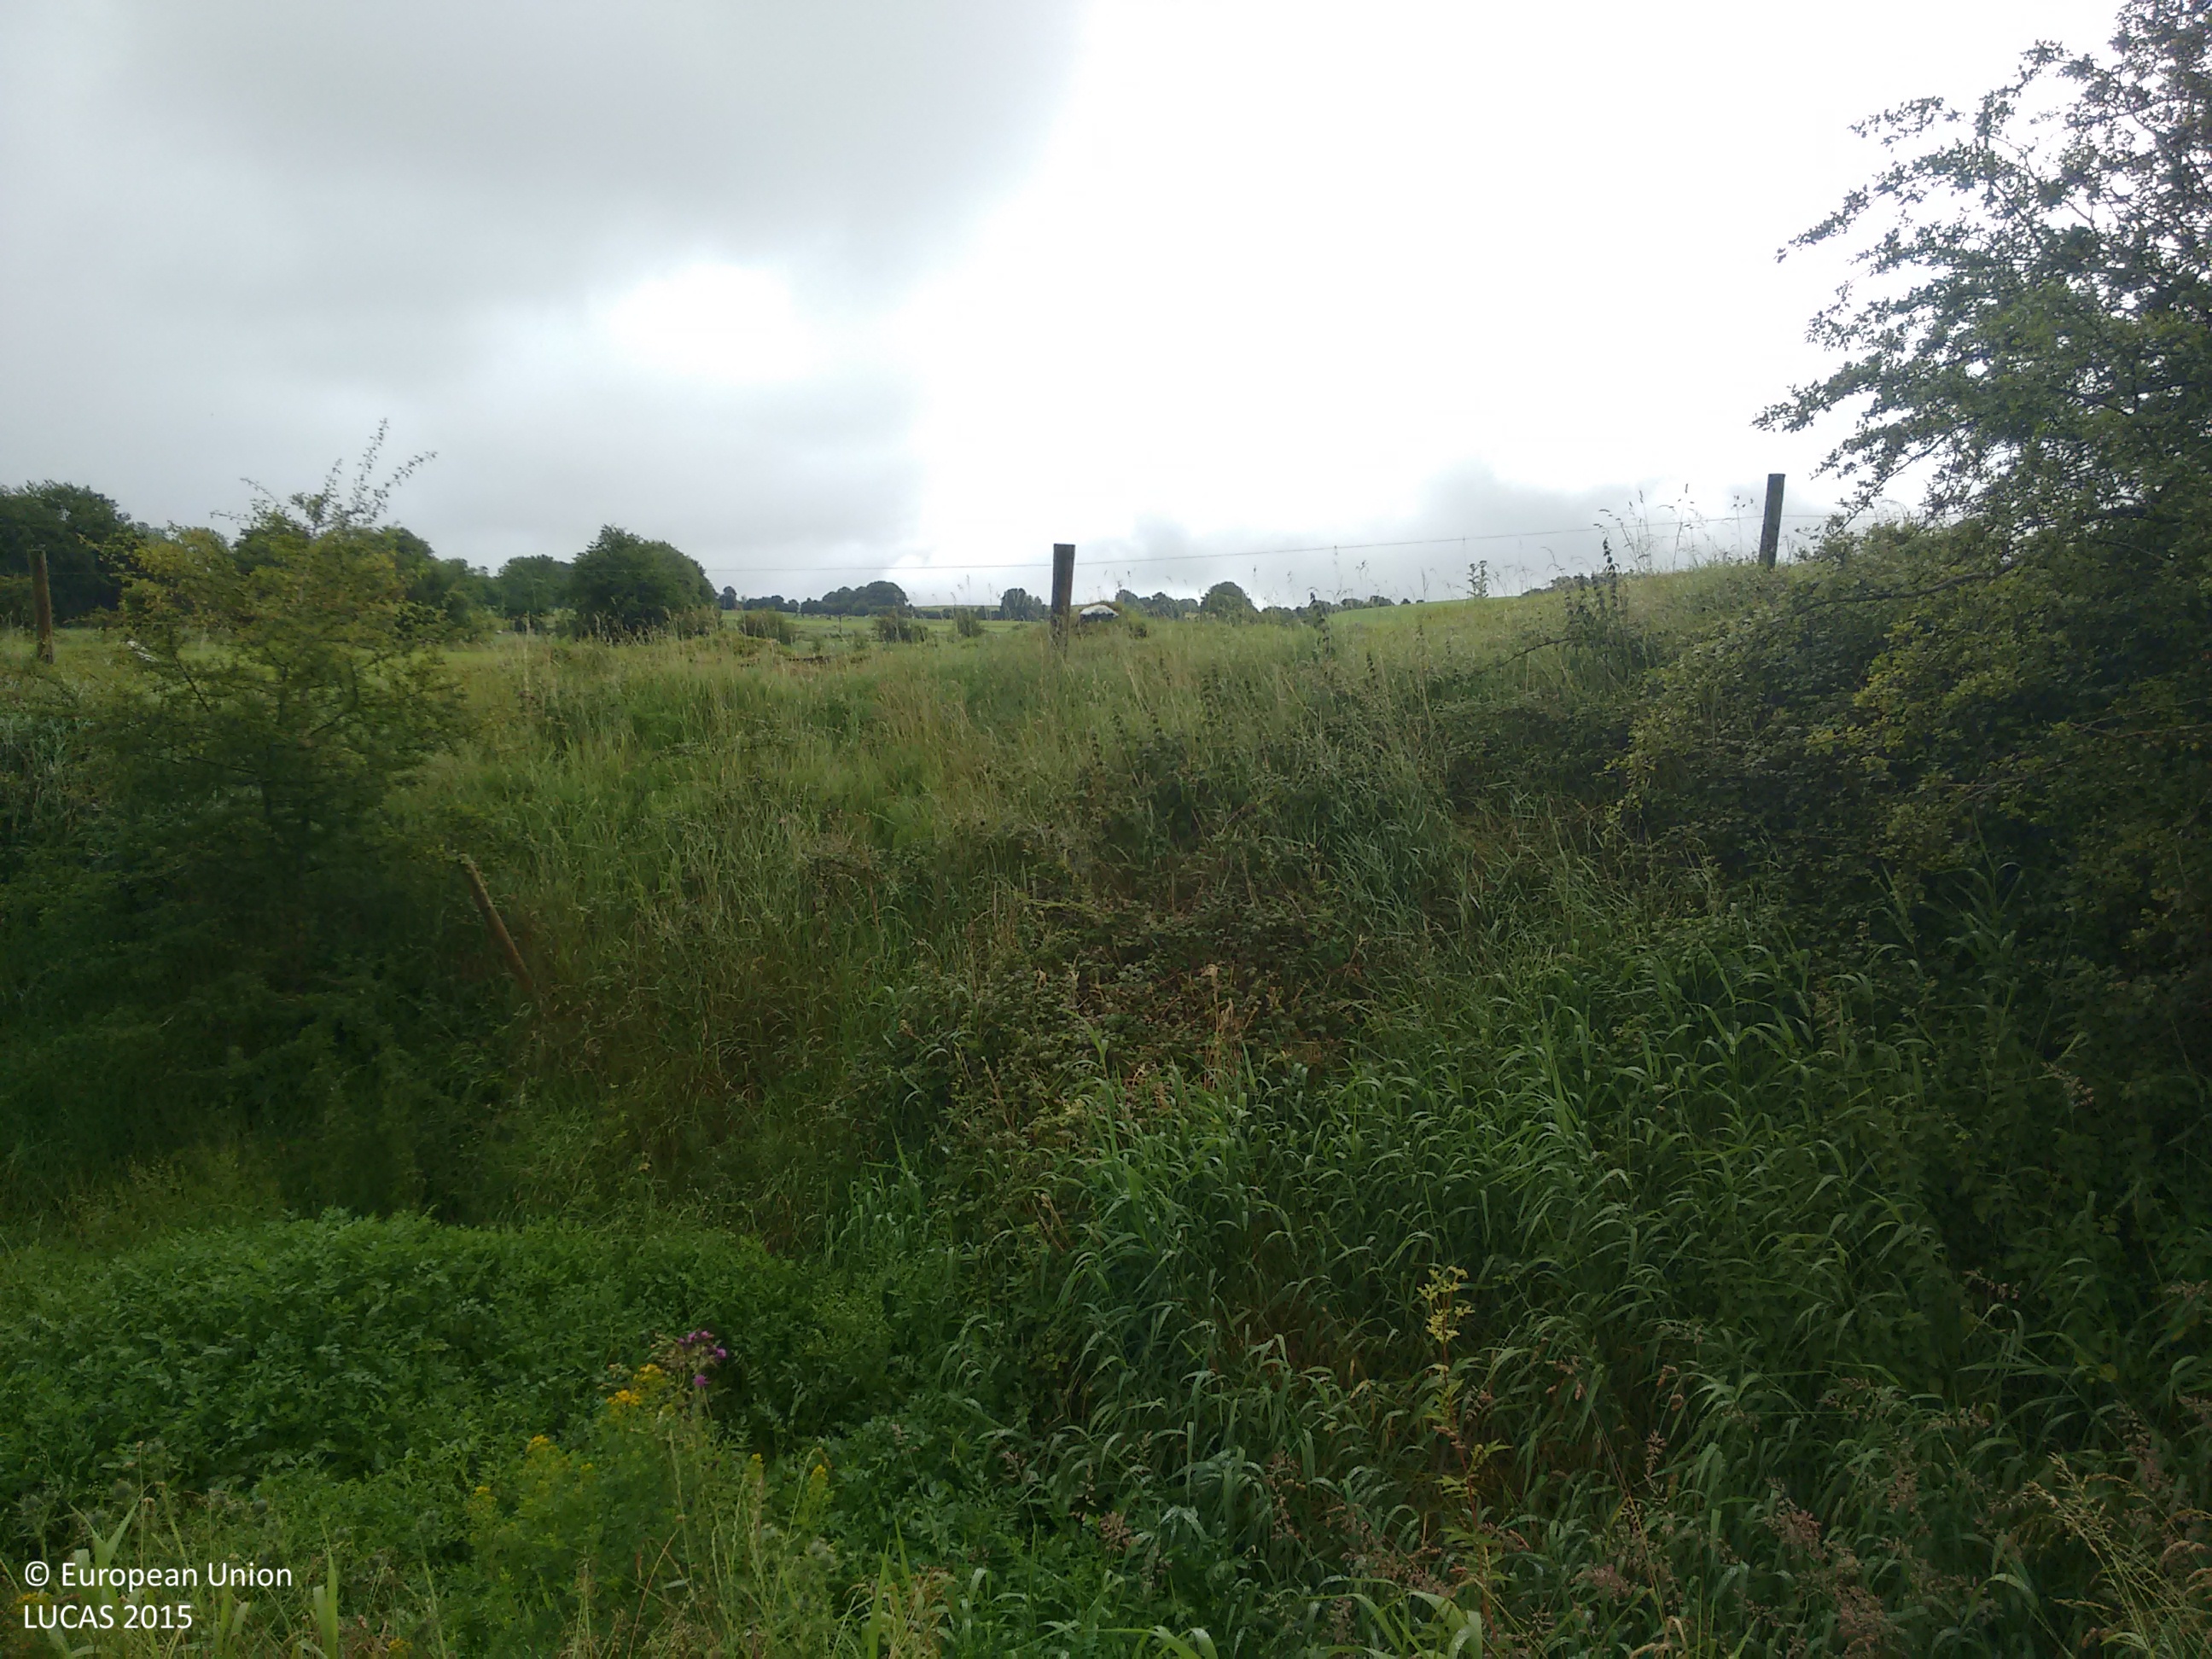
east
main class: Grassland
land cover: Grassland without tree/shrub cover
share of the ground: > 75 %
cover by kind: herbaceous plants 100 %
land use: Agriculture (excluding fallow land and kitchen gardens)
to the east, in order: Grassland without tree/shrub cover; Fences; Shrubland with sparse tree cover; Rivers and streams; Shrubland with sparse tree cover; Fences; Grassland without tree/shrub cover
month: July
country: IE
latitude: 53.4806
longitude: -7.8452
